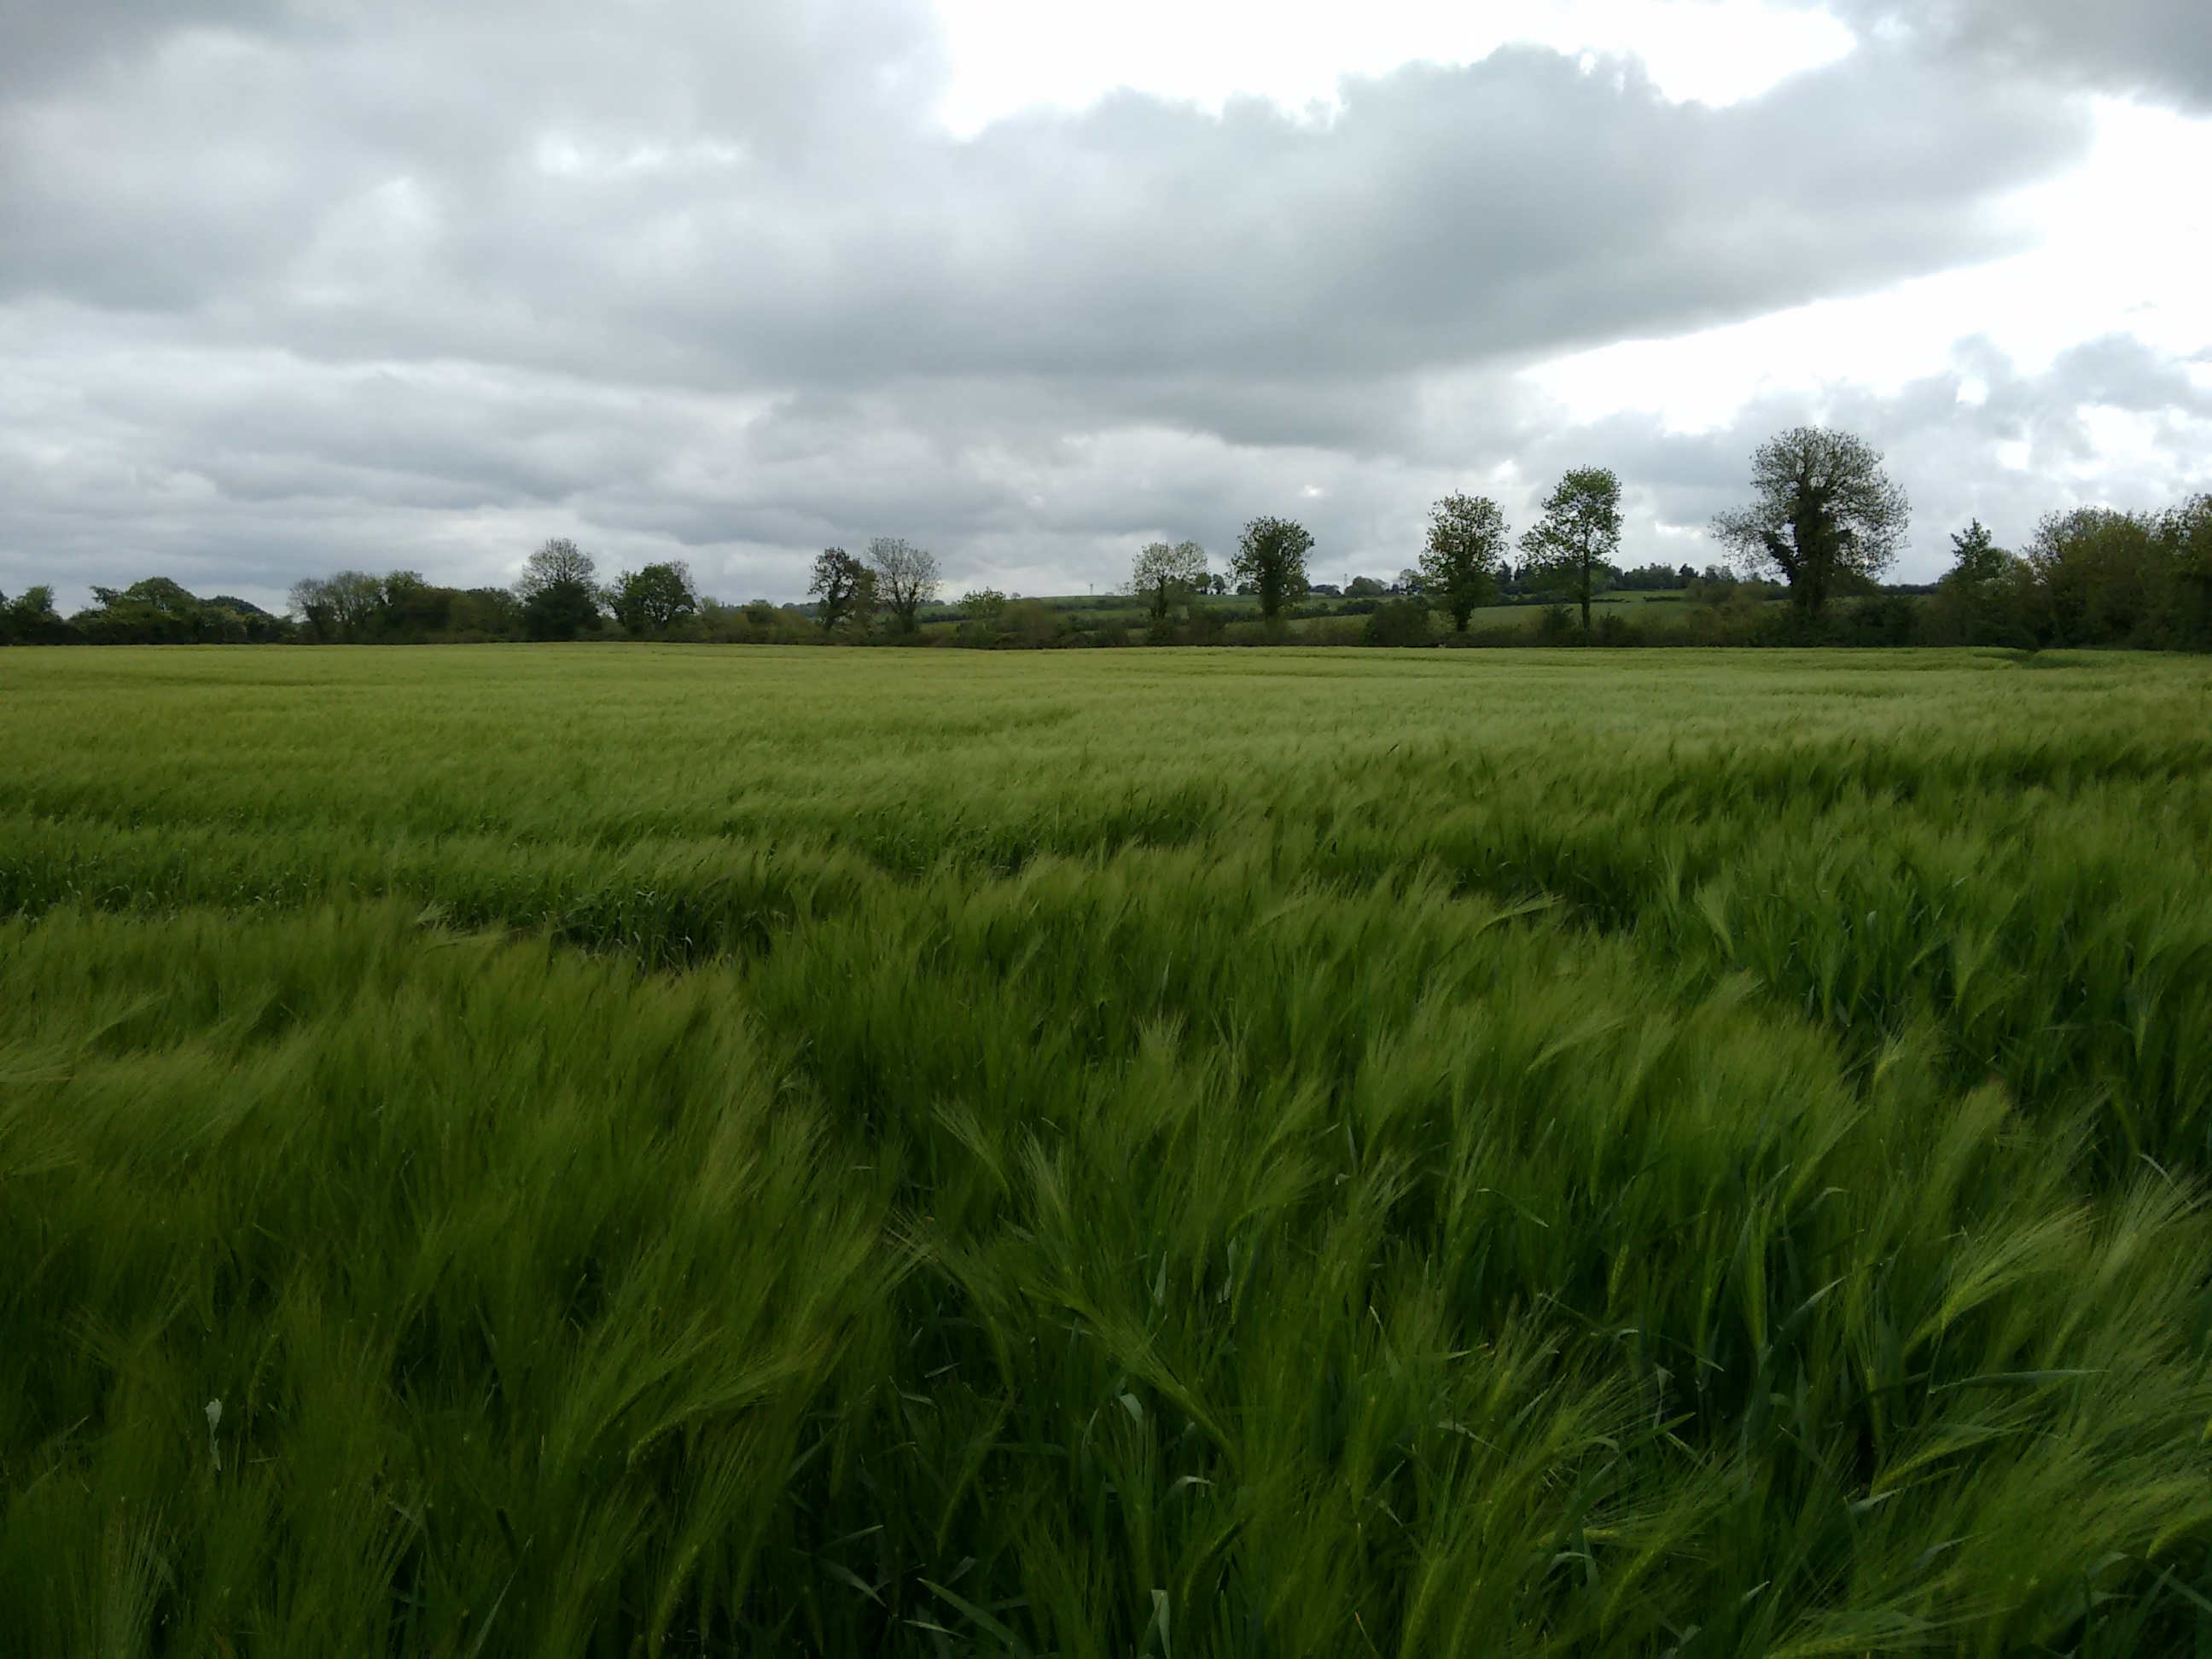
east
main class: Cropland
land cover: Barley
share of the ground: > 75 %
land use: Agriculture (excluding fallow land and kitchen gardens)
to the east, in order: Barley; Grass margins; Managed hedges; Grass margins; Barley
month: May
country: IE
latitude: 53.4856
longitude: -6.6637
